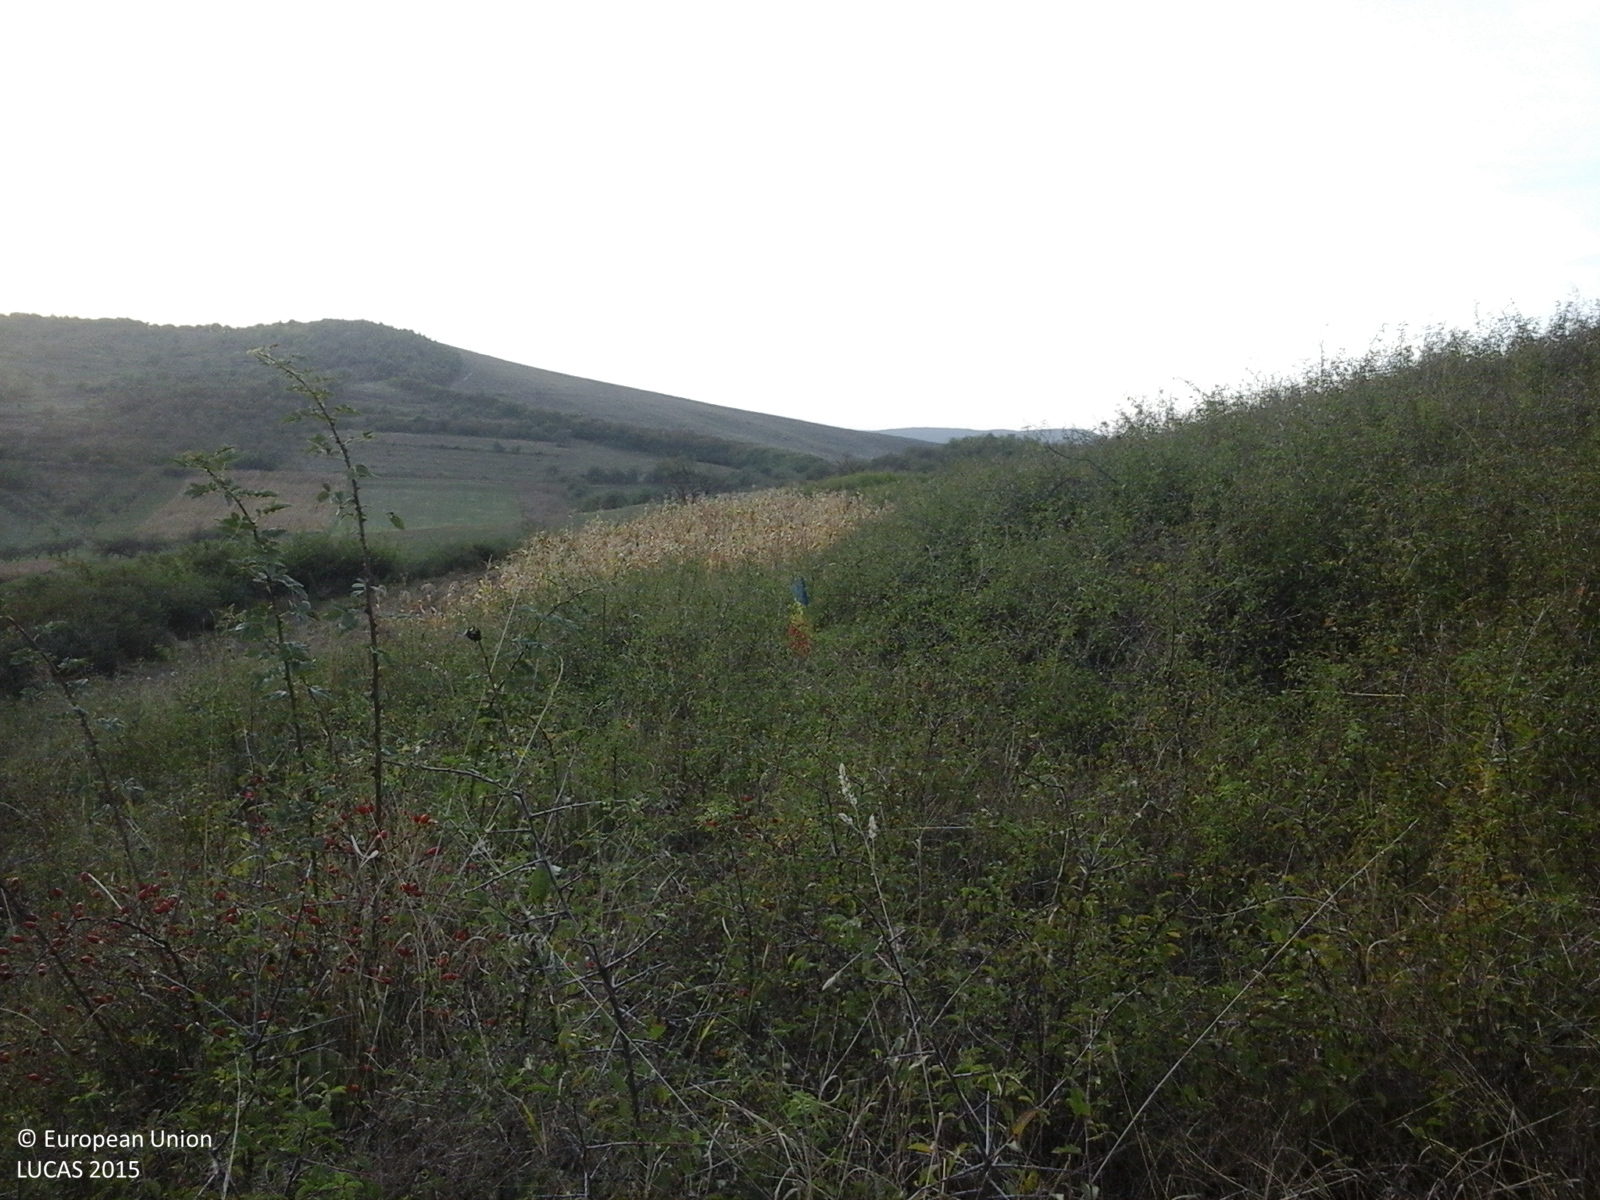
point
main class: Shrubland
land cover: Shrubland without tree cover
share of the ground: > 75 %
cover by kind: shrubs 100 %
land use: Semi-natural and natural areas not in use
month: September
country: RO
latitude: 47.1245
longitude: 23.8530
